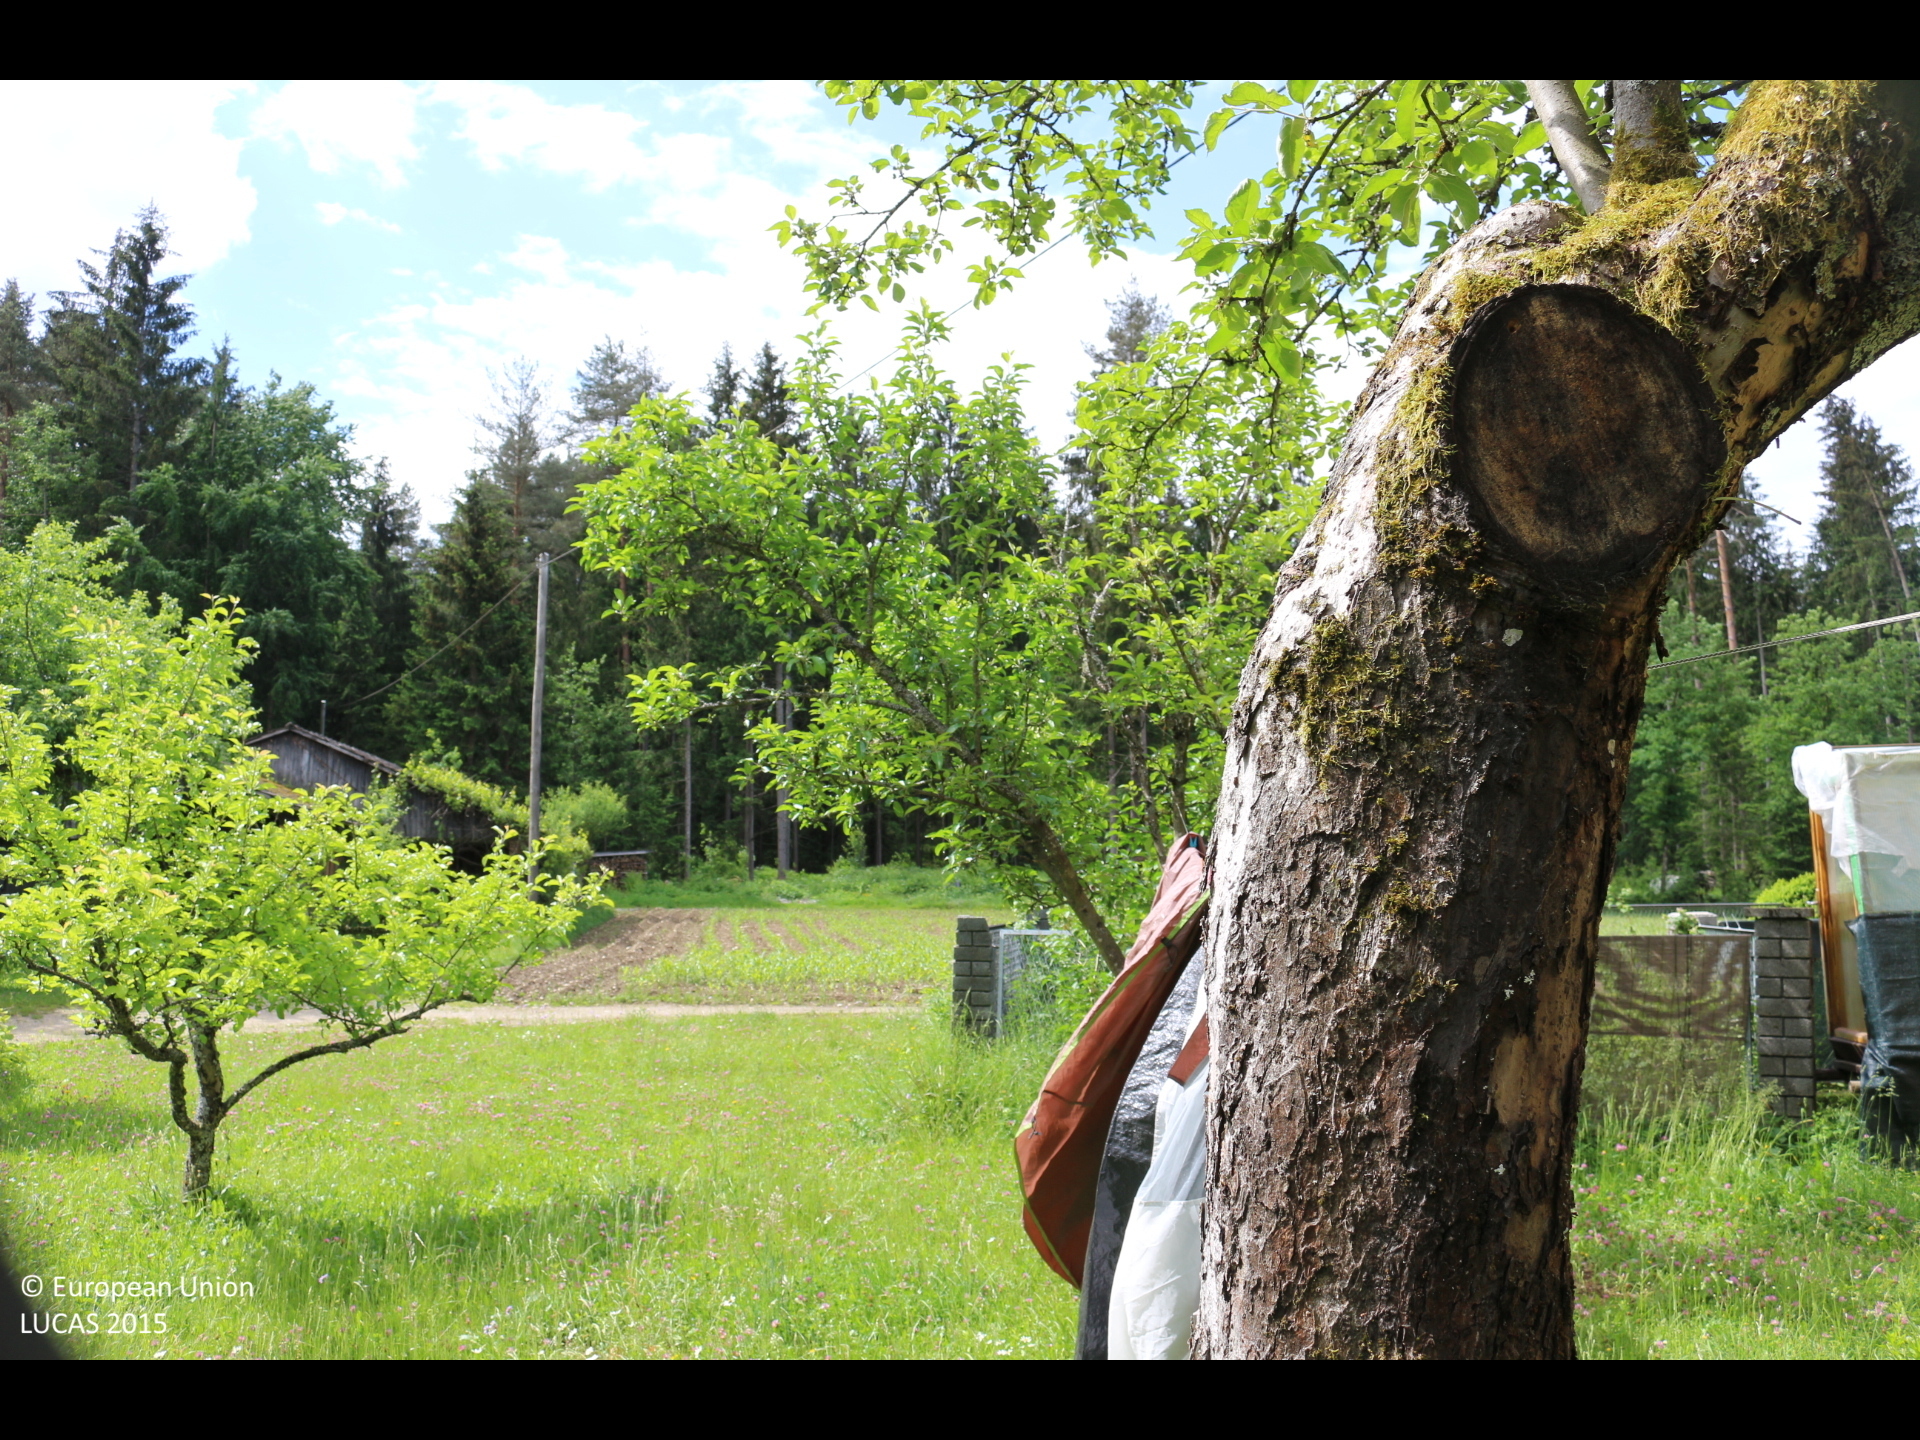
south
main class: Cropland
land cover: Apple fruit
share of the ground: 25 - 50 %
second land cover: Grassland without tree/shrub cover
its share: > 75 %
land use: Kitchen garden
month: May
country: AT
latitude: 46.6442
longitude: 14.7142
